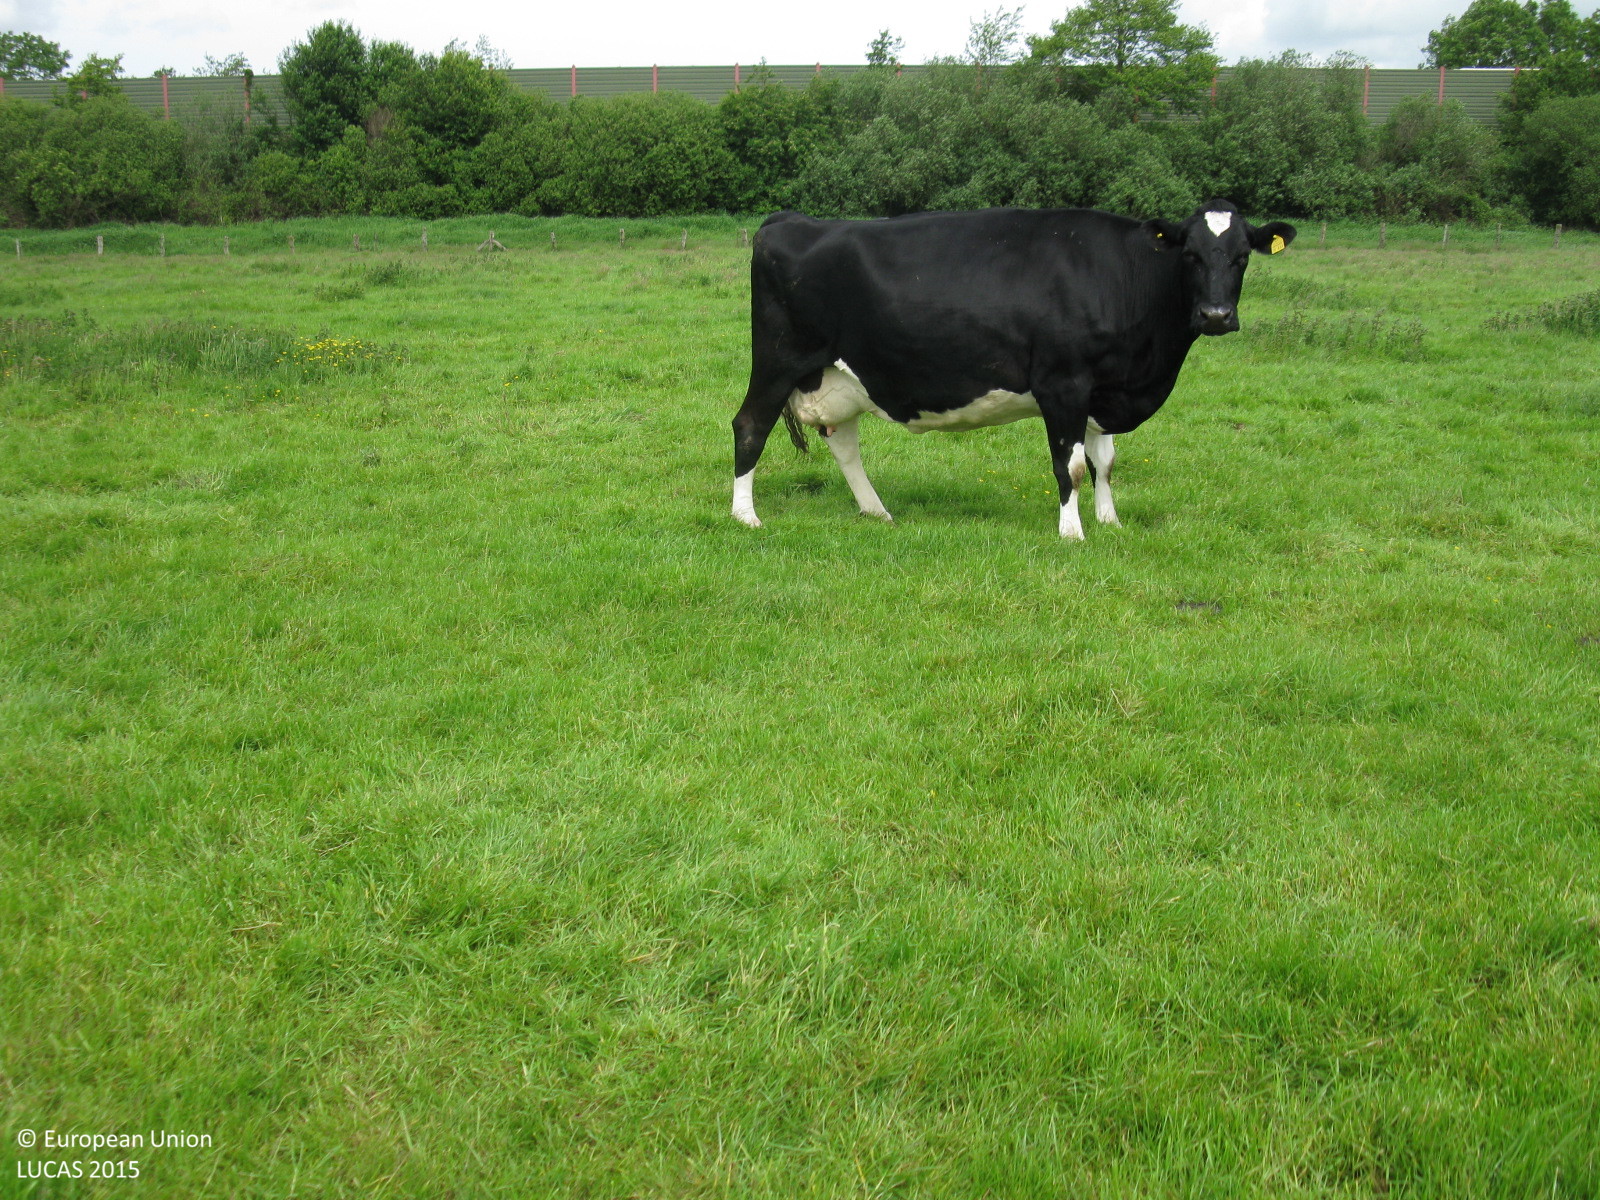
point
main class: Grassland
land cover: Grassland without tree/shrub cover
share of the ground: > 75 %
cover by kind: herbaceous plants 100 %
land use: Agriculture (excluding fallow land and kitchen gardens)
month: June
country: DE
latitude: 53.2105
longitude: 7.3203
